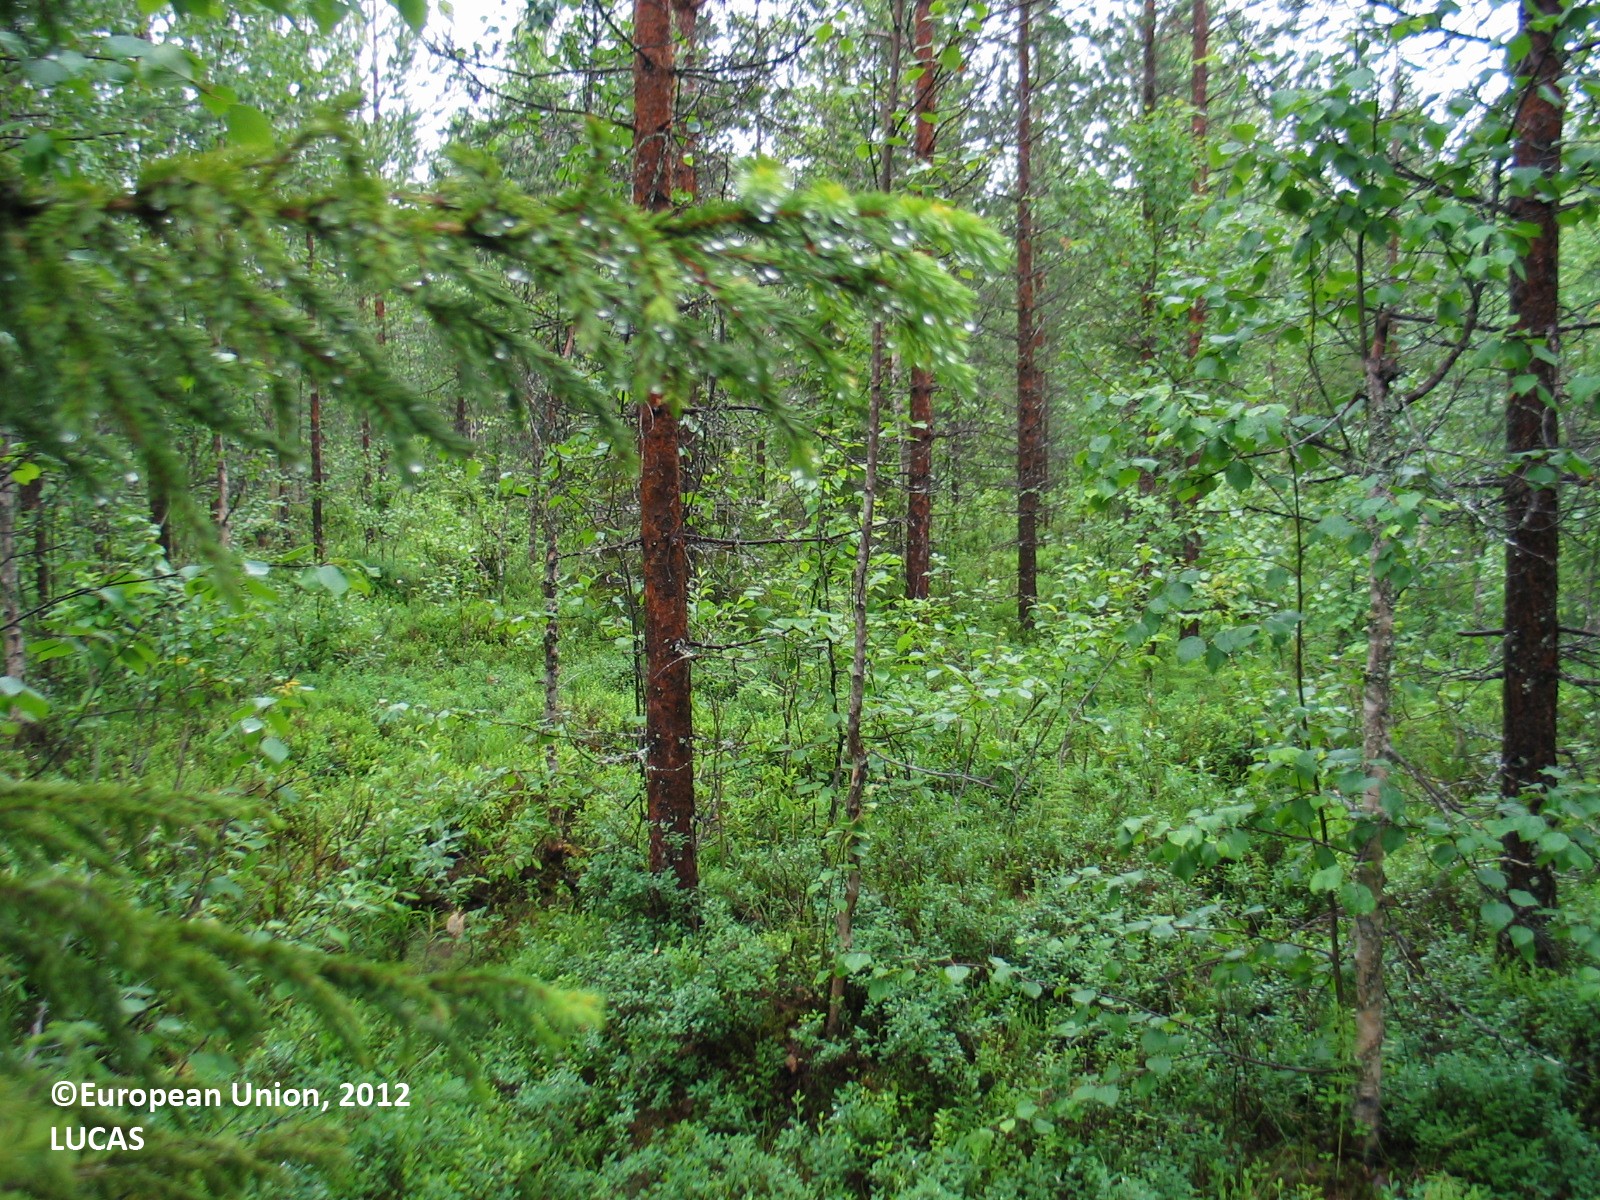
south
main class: Woodland
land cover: Pine dominated coniferous woodland
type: boreal forest
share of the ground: 25 - 50 %
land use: Forestry
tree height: > 5 m
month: July
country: FI
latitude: 66.0034
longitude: 25.2484
